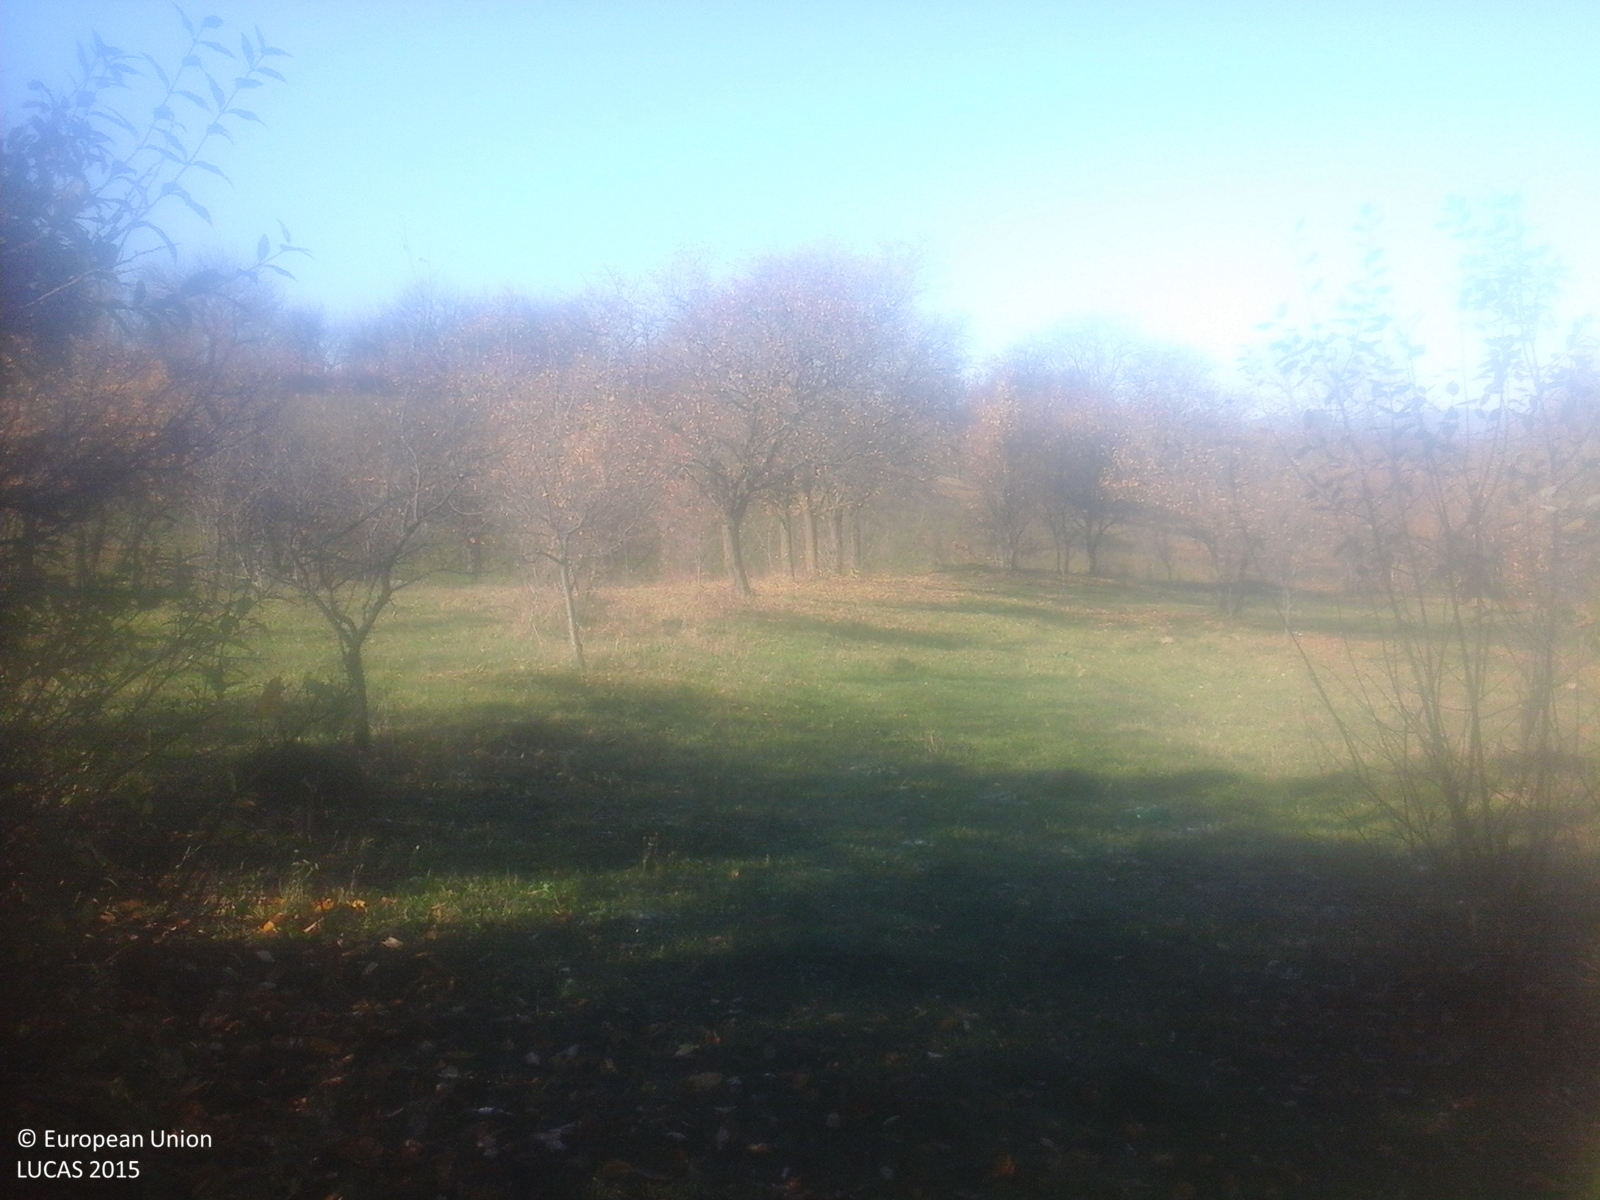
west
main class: Cropland
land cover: Other fruit trees and berries
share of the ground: > 75 %
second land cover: Grassland without tree/shrub cover
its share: > 75 %
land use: Agriculture (excluding fallow land and kitchen gardens)
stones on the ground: < 10 %
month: October
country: RO
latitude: 45.9031
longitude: 26.9631
